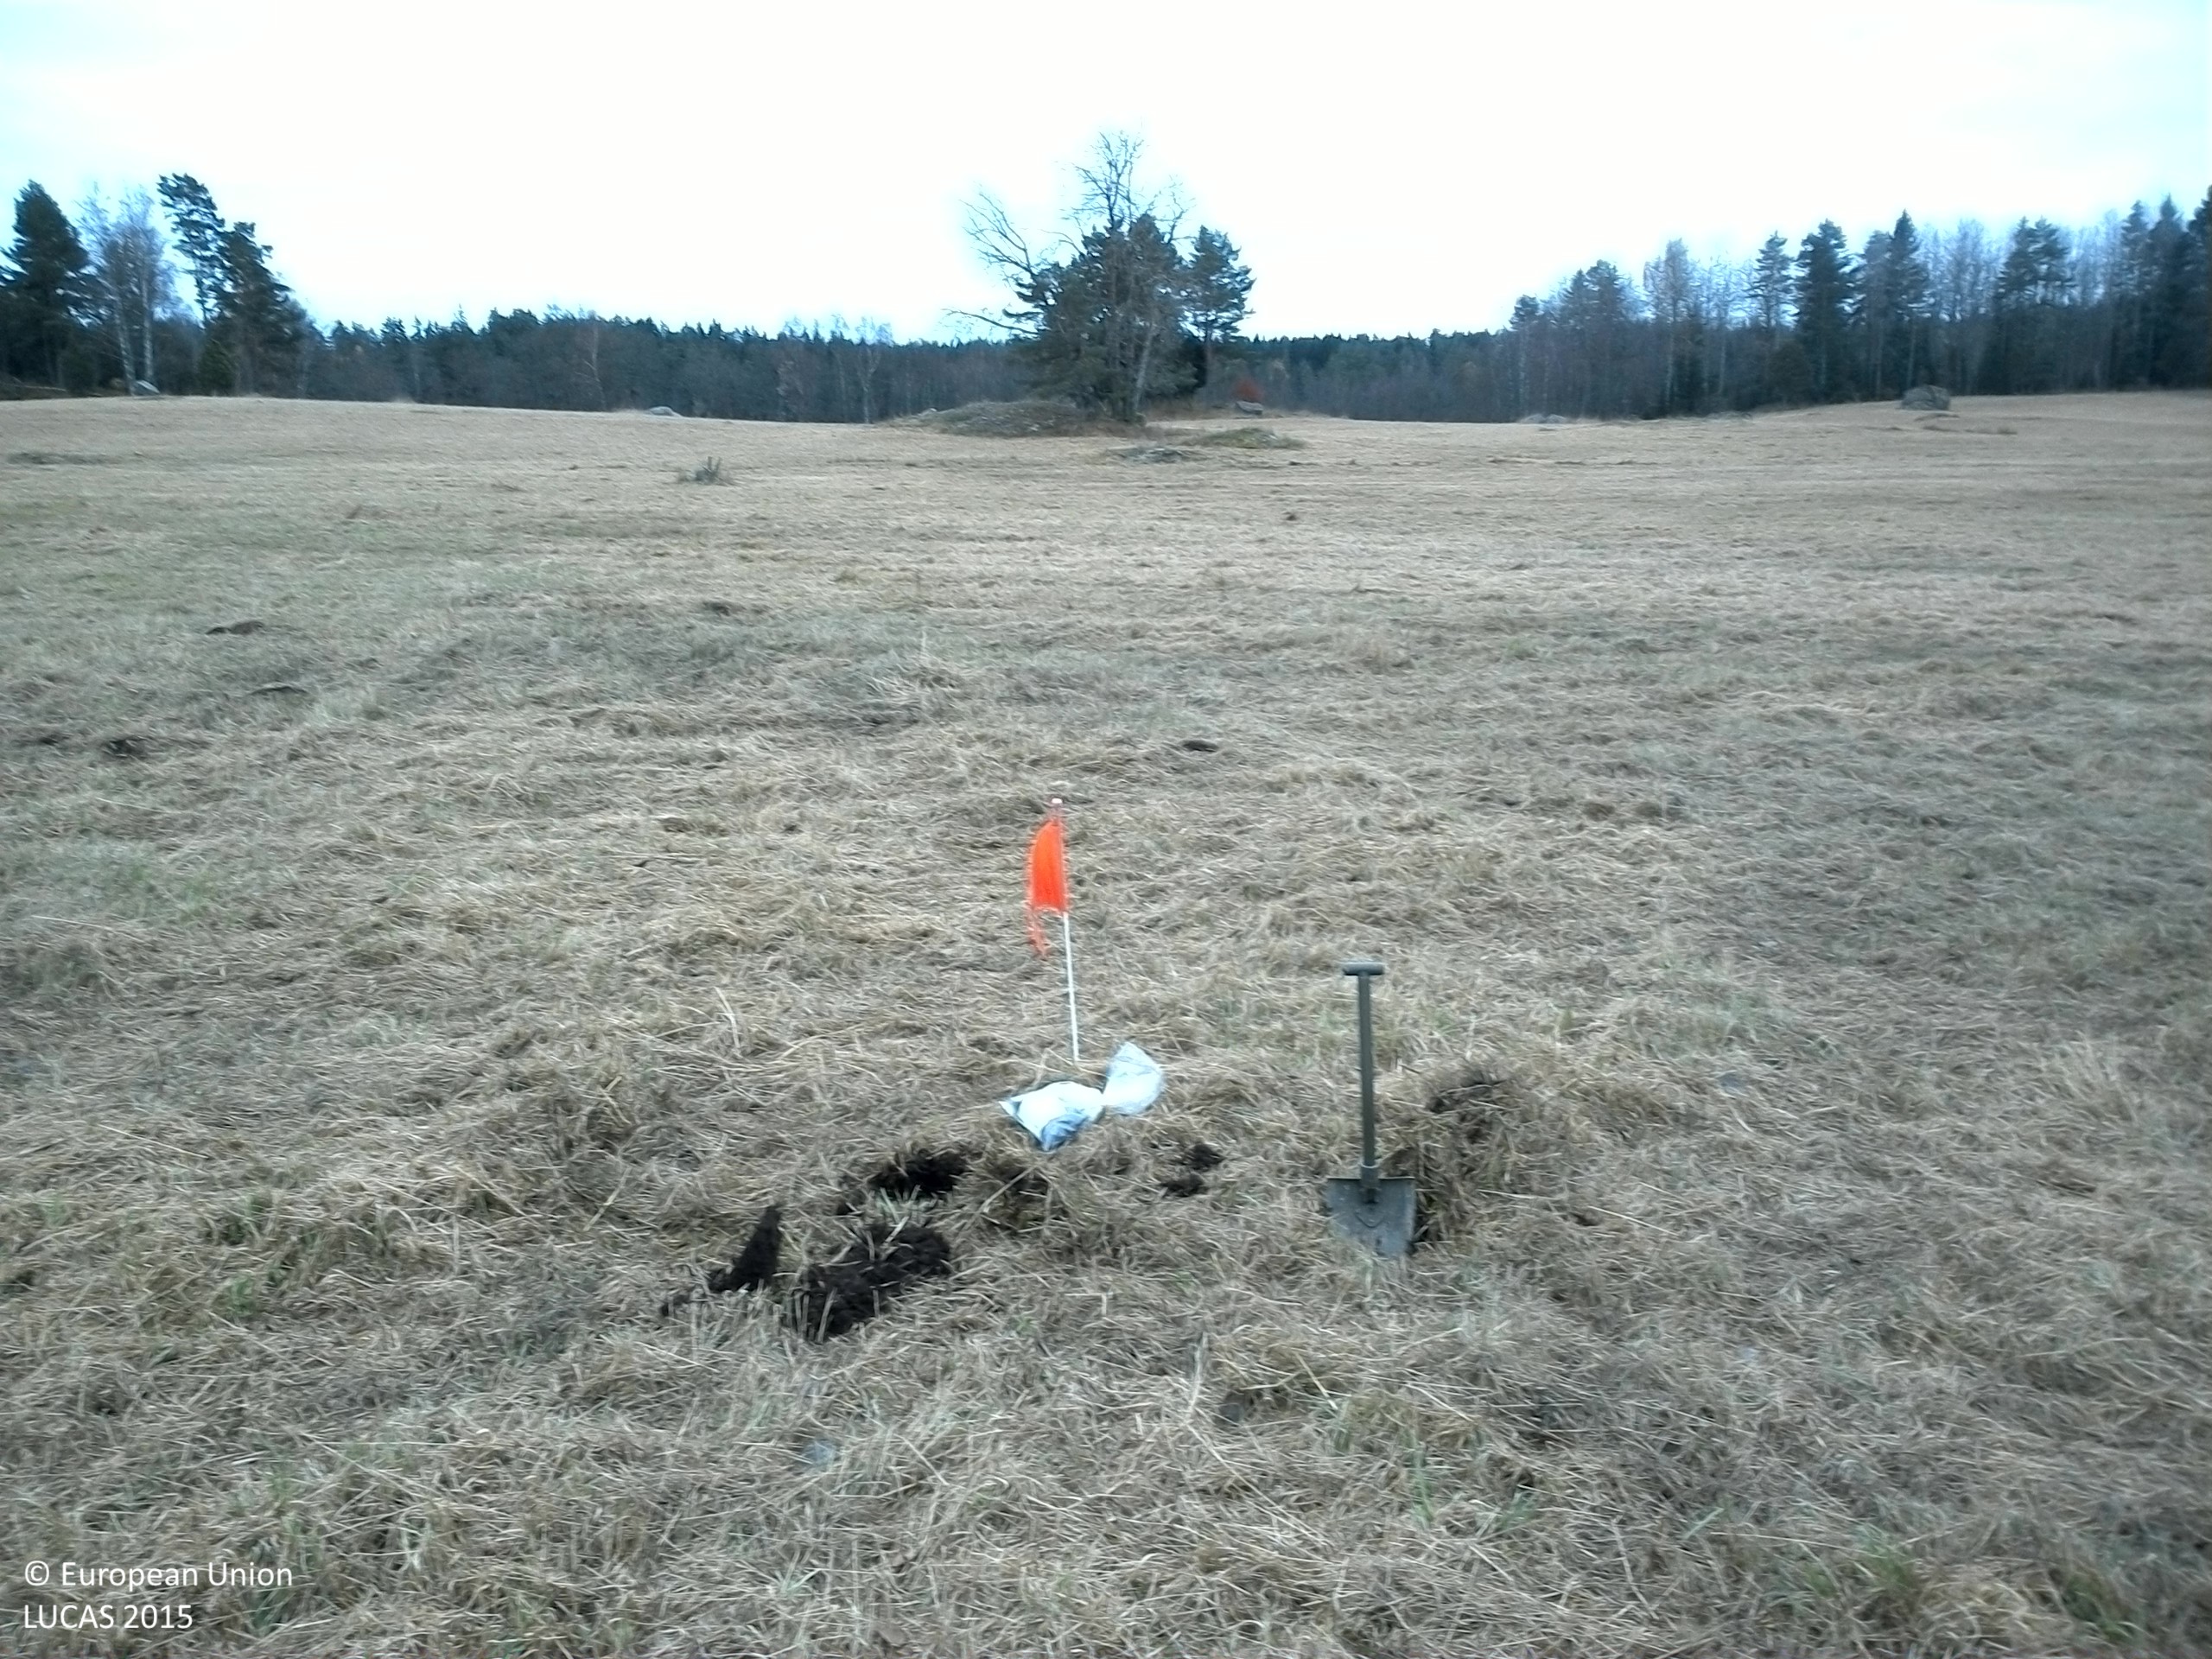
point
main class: Grassland
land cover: Grassland without tree/shrub cover
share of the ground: > 75 %
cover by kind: herbaceous plants 100 %
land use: Agriculture (excluding fallow land and kitchen gardens)
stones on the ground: < 10 %
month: October
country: SE
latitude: 59.1372
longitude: 17.0386
